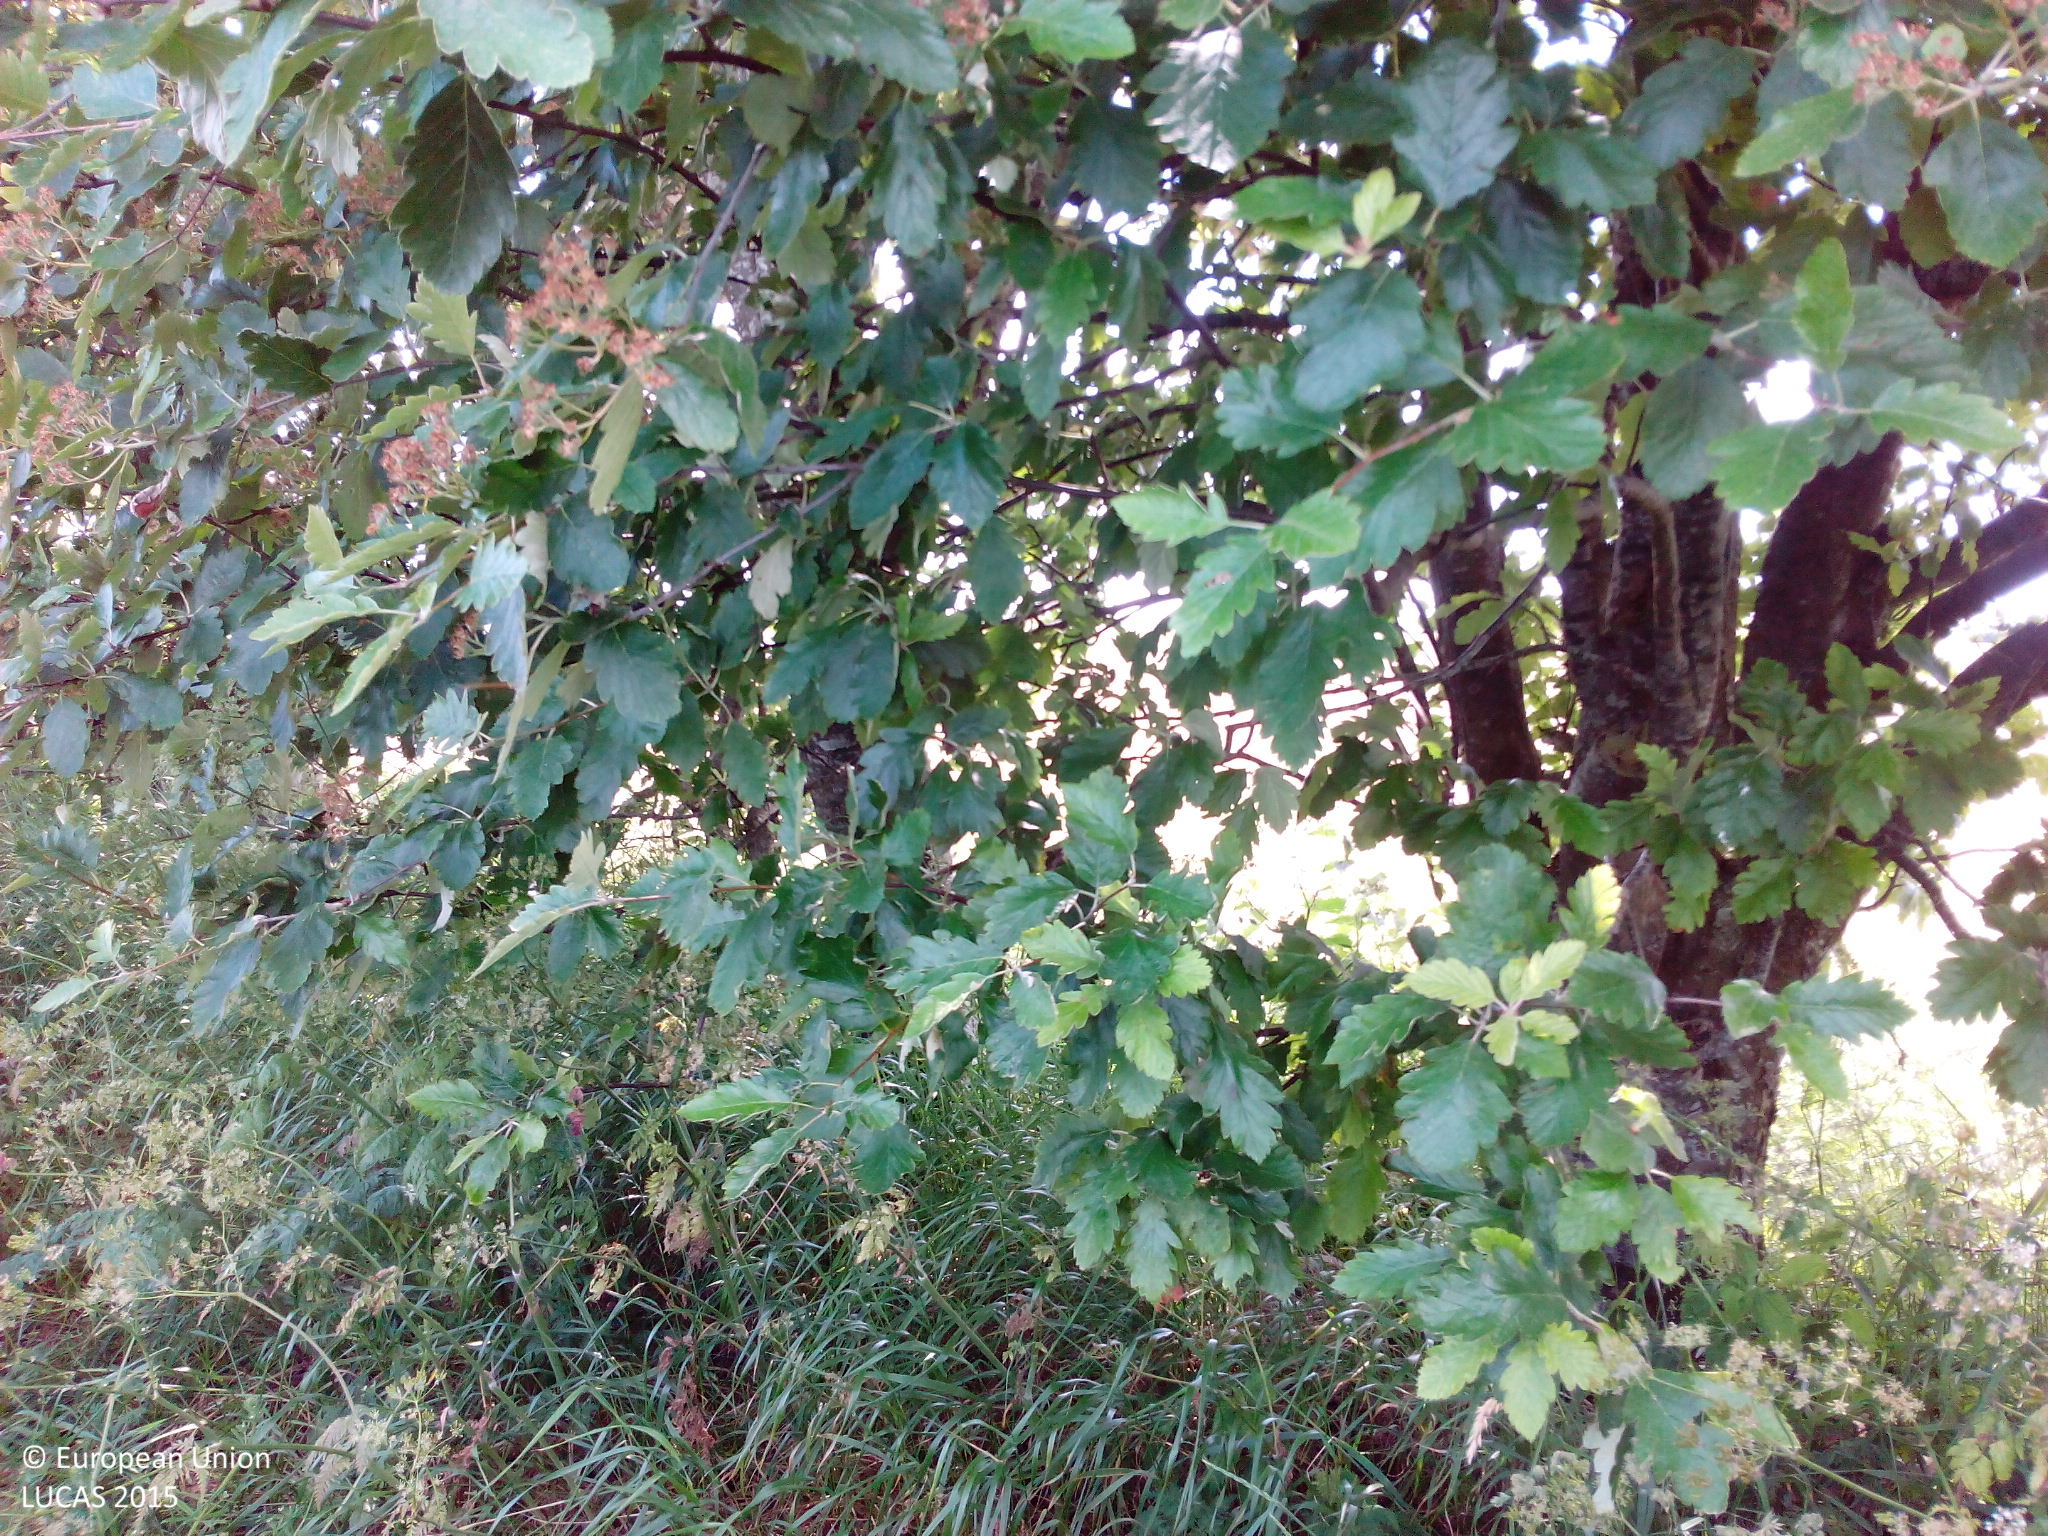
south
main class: Cropland
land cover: Rape and turnip rape
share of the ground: > 75 %
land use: Agriculture (excluding fallow land and kitchen gardens)
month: June
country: DK
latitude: 56.3109
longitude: 10.8234
